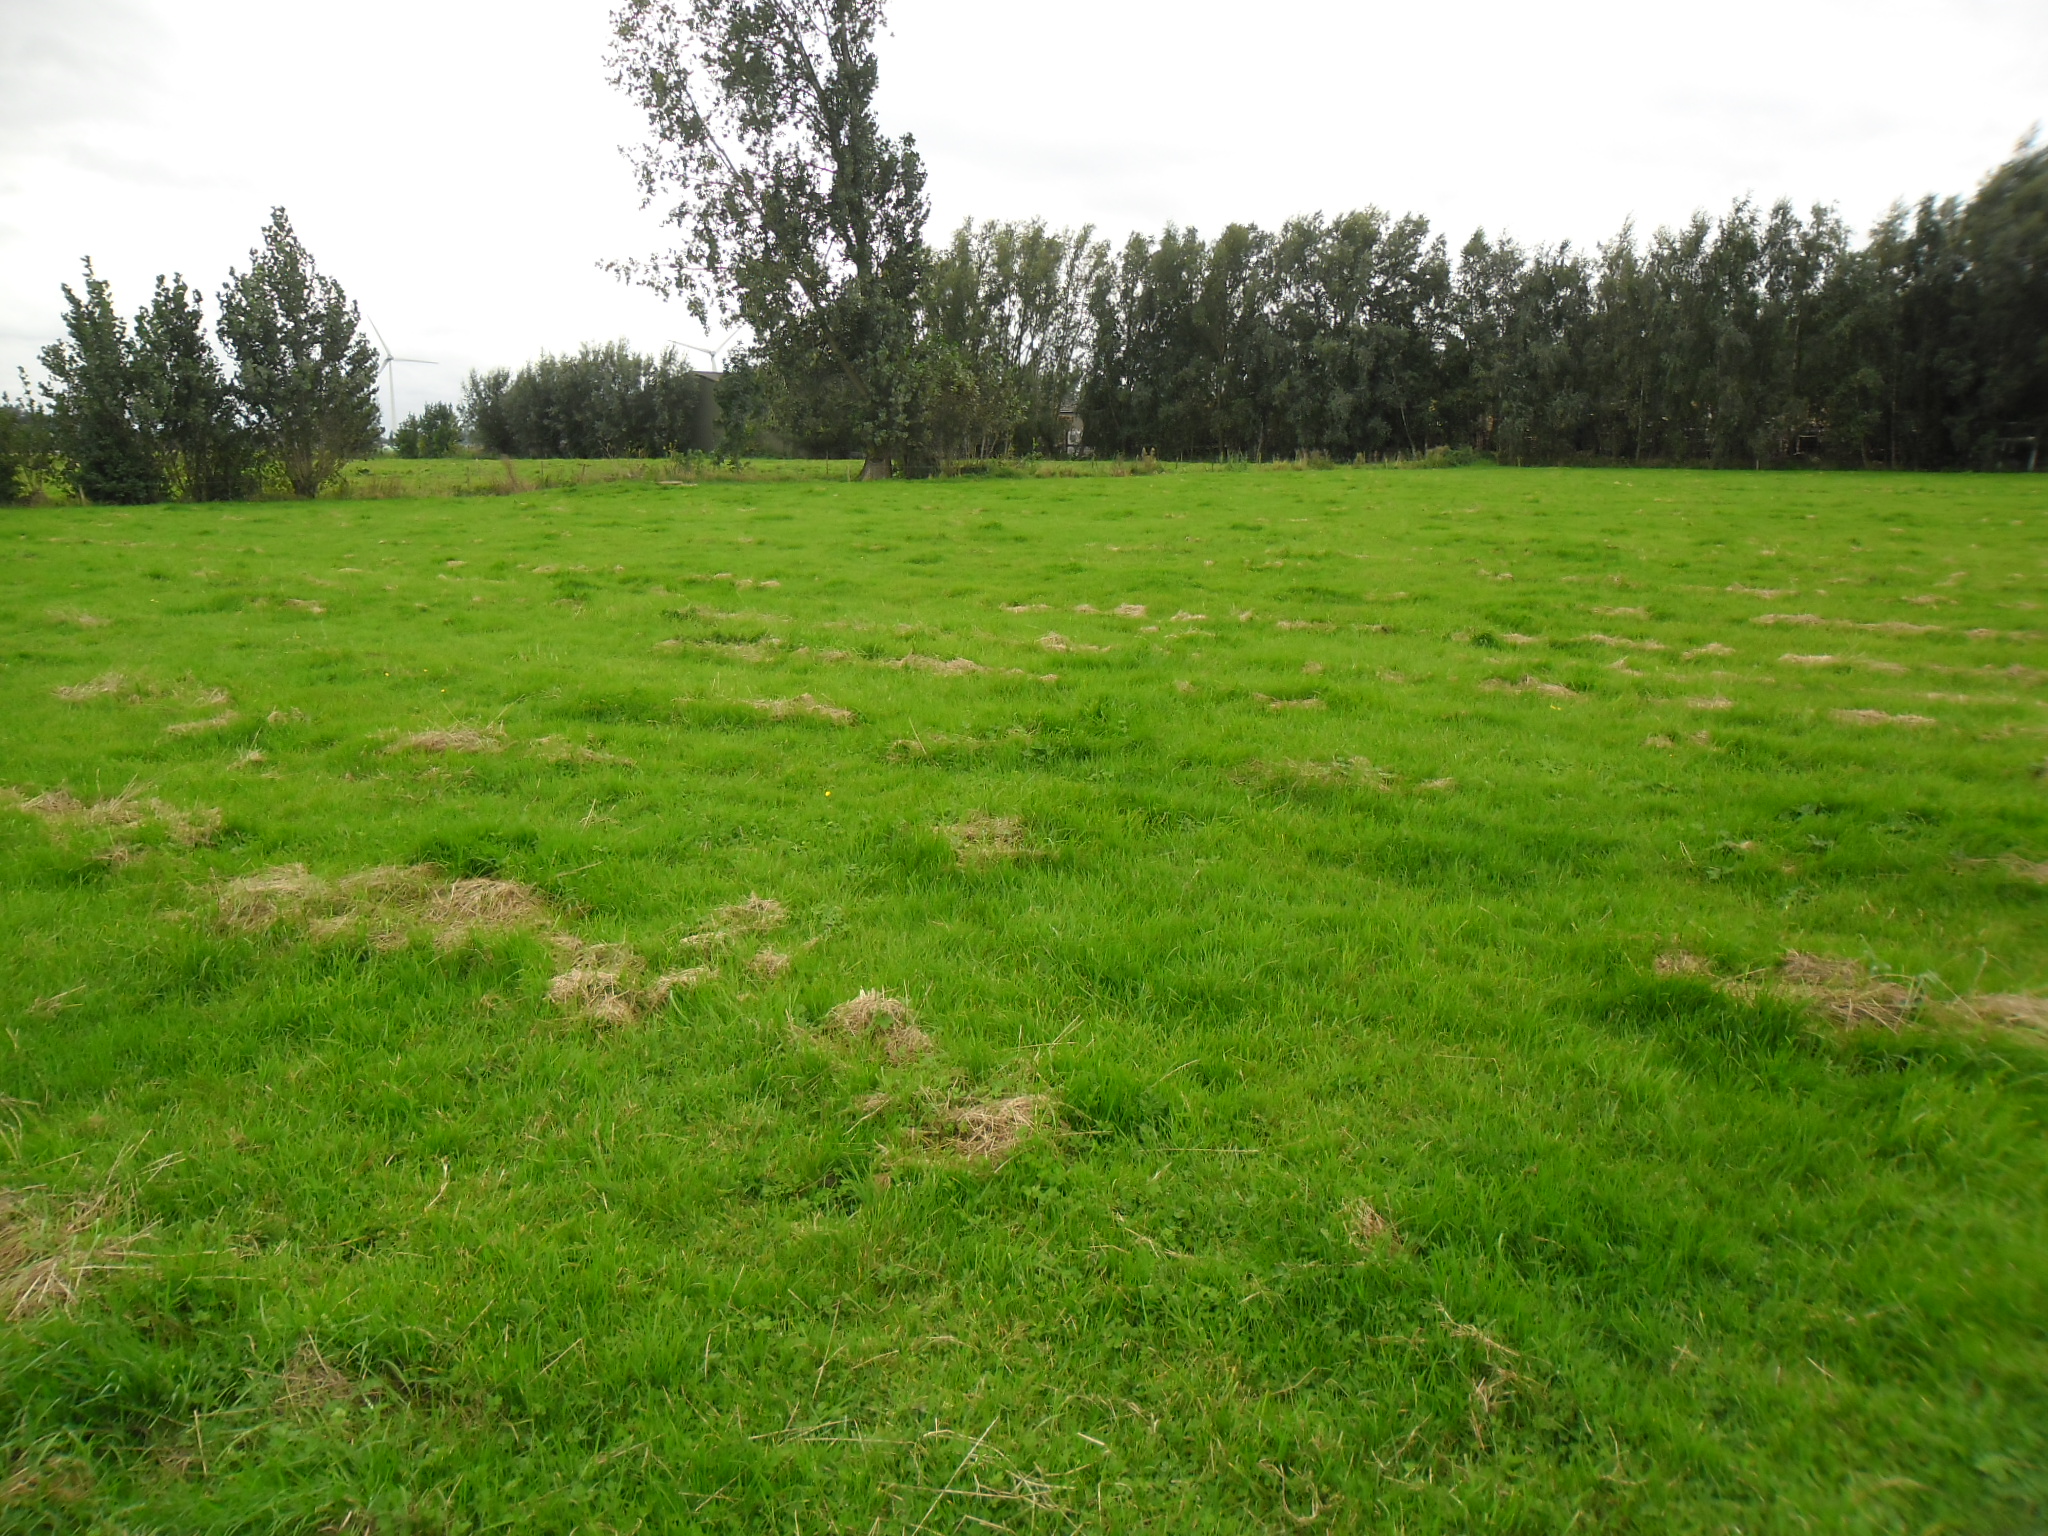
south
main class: Grassland
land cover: Grassland without tree/shrub cover
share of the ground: > 75 %
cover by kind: herbaceous plants 100 %
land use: Agriculture (excluding fallow land and kitchen gardens)
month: September
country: NL
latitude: 51.9323
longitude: 5.5042
